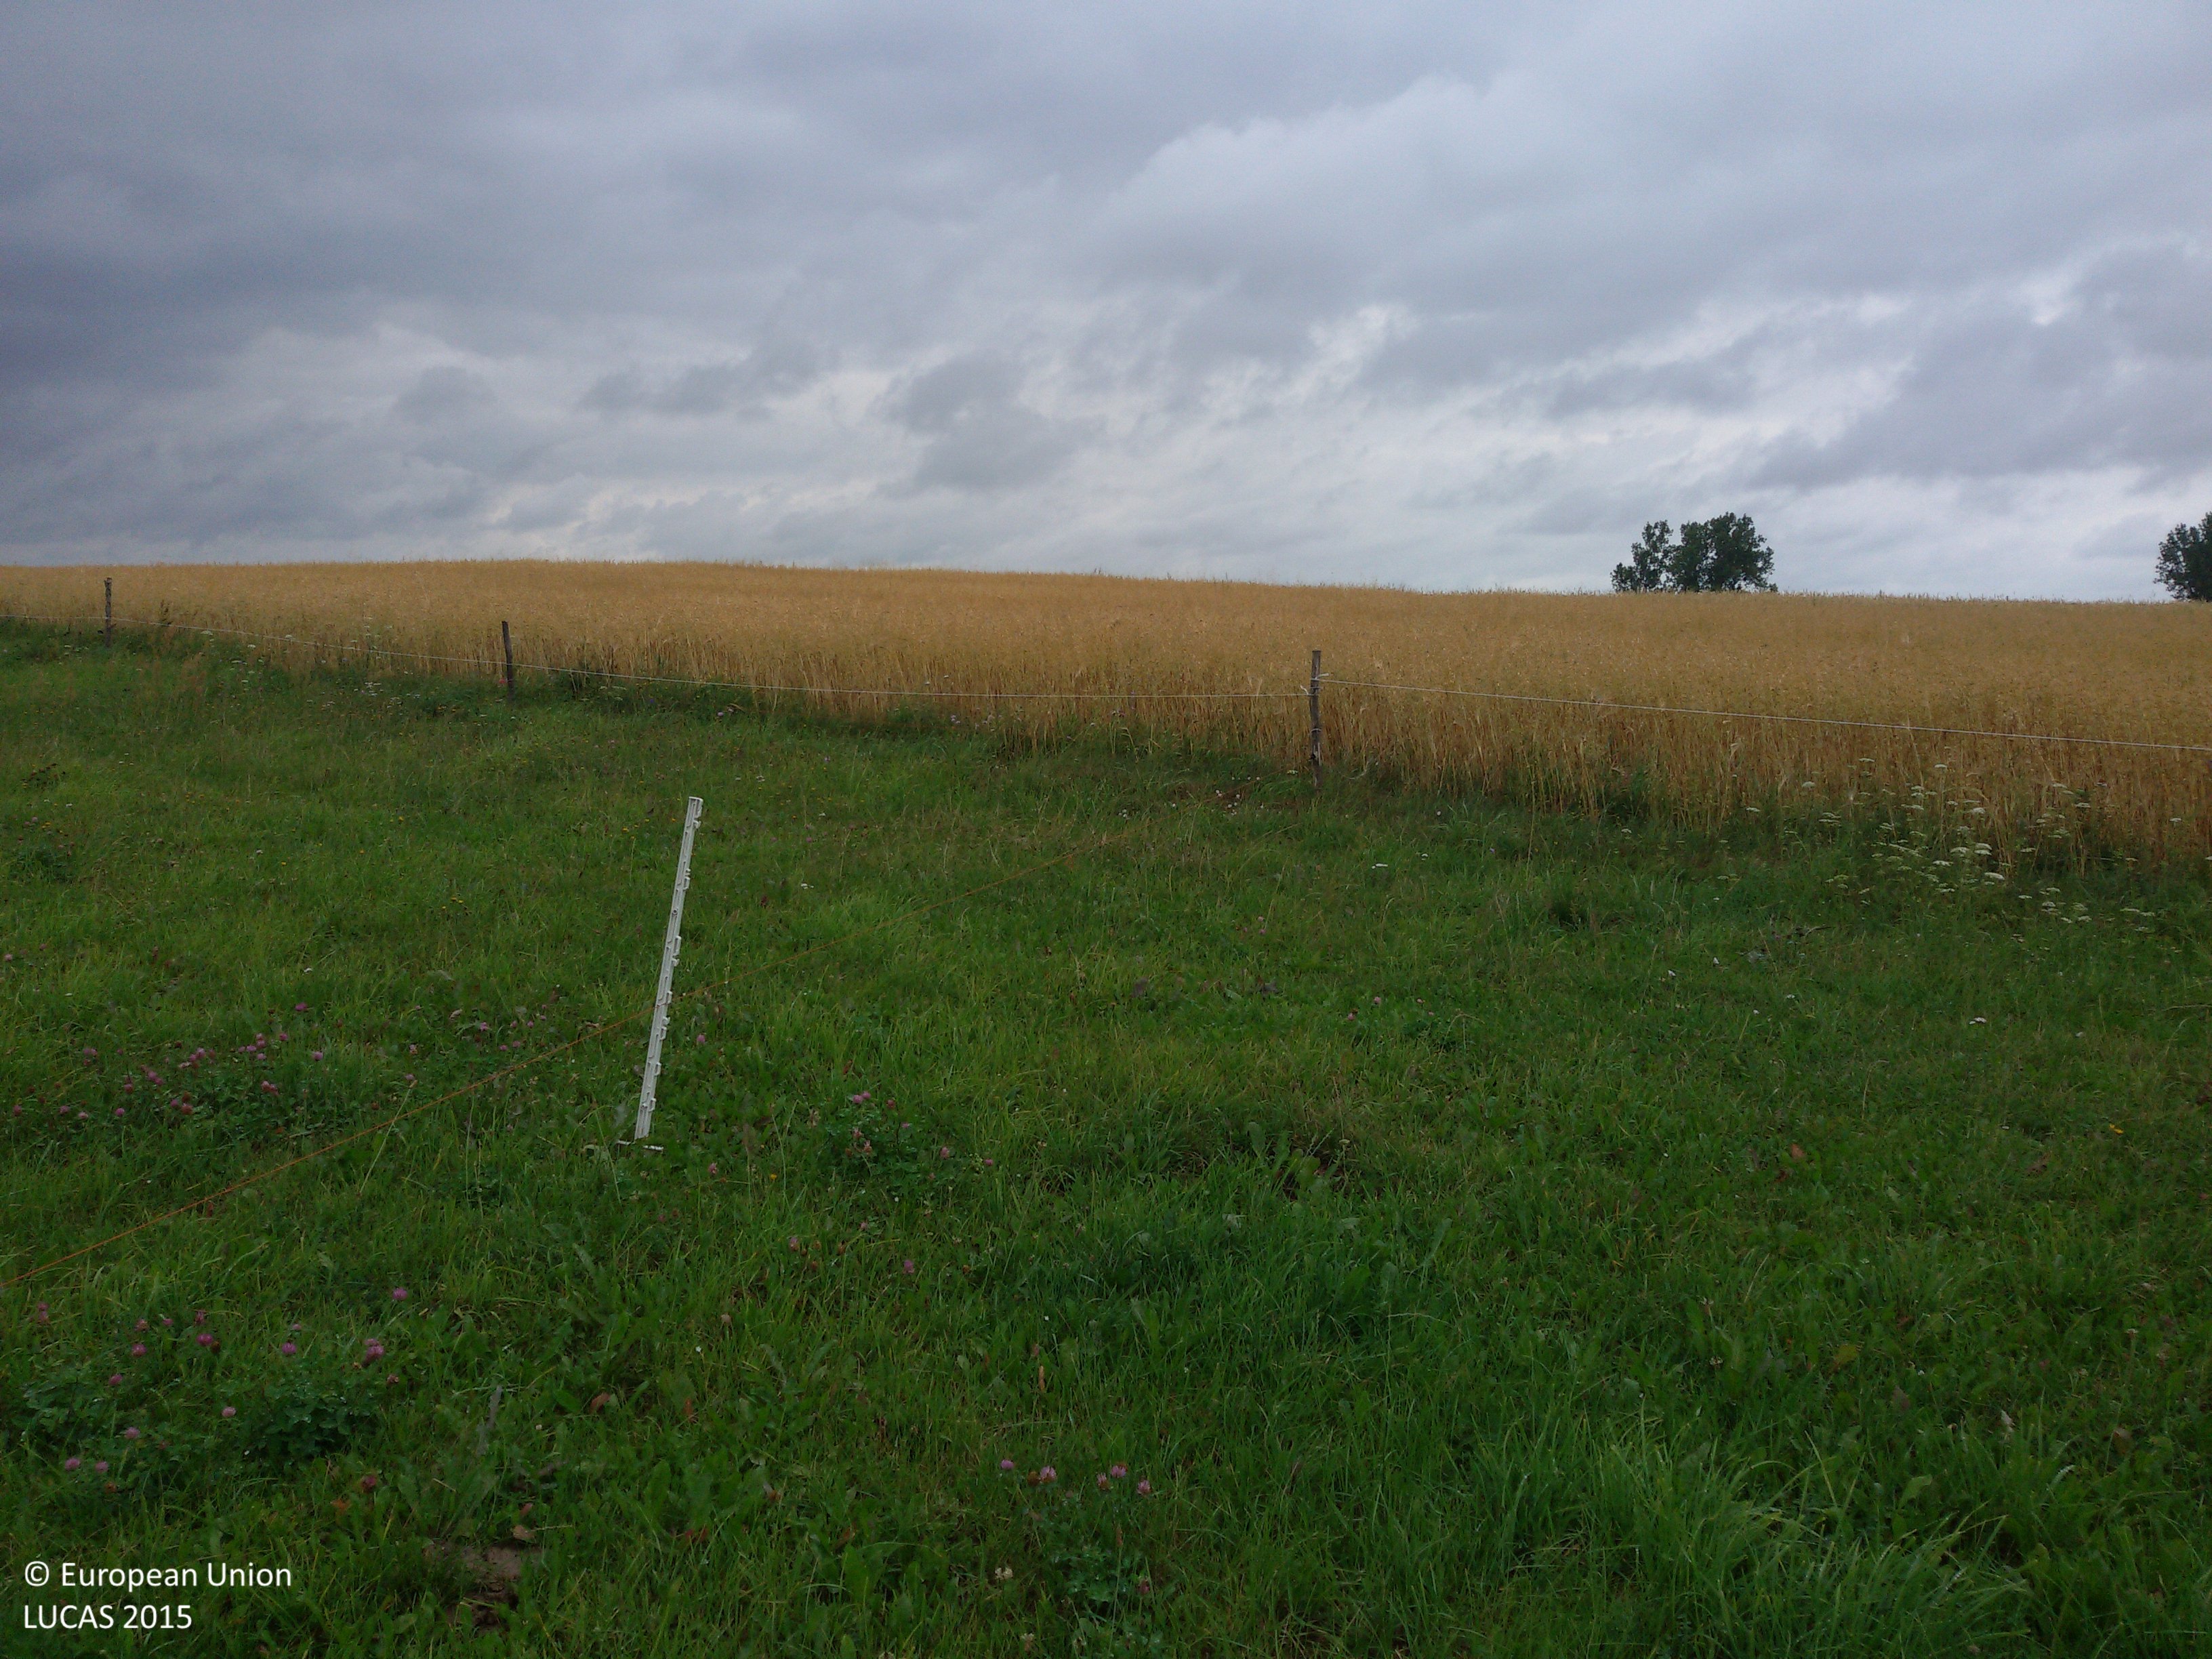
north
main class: Grassland
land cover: Grassland without tree/shrub cover
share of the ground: > 75 %
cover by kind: herbaceous plants 100 %
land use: Agriculture (excluding fallow land and kitchen gardens)
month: July
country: PL
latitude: 53.5851
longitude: 23.5436
